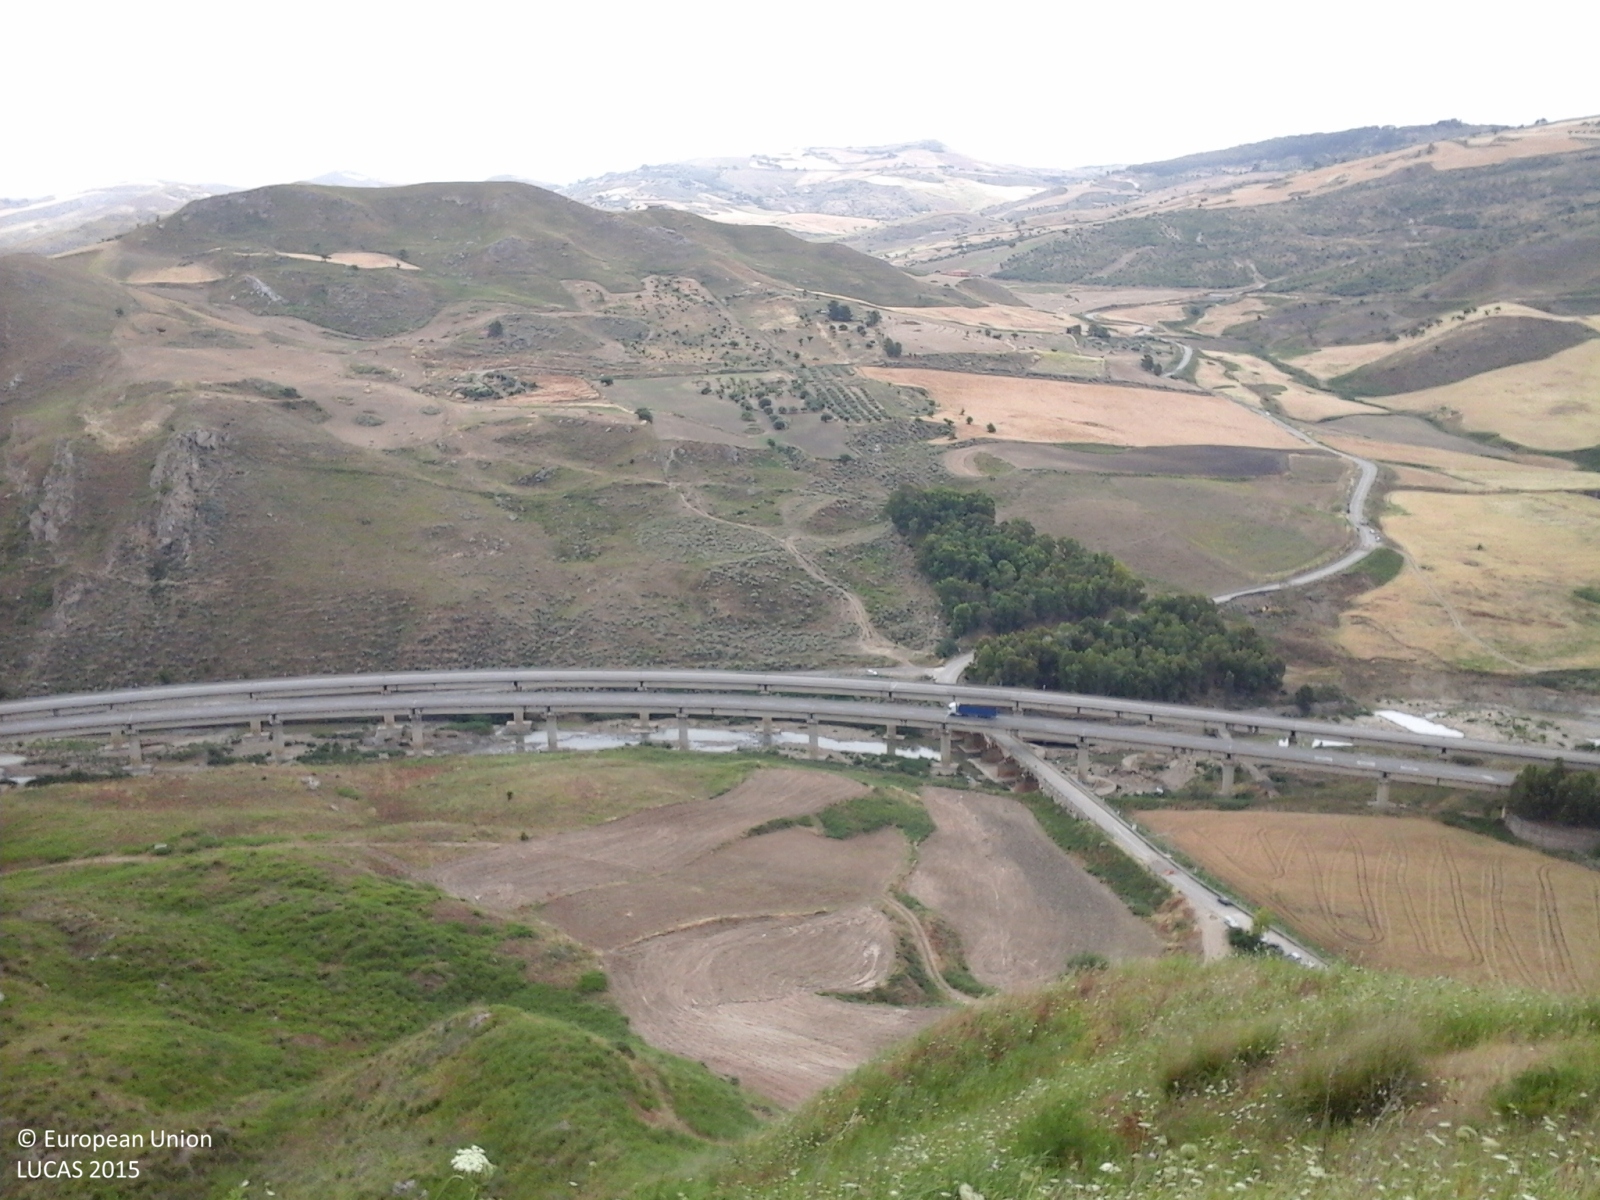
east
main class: Grassland
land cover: Grassland without tree/shrub cover
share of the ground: > 75 %
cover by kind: herbaceous plants 70 %, consolidated bare surface 20 %, unconsolidated bare surface 10 %
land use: Agriculture (excluding fallow land and kitchen gardens)
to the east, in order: Grassland without tree/shrub cover; Grassland with sparse tree/shrub cover; Other bare soil; Grassland without tree/shrub cover
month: June
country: IT
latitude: 37.6034
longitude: 14.1268
